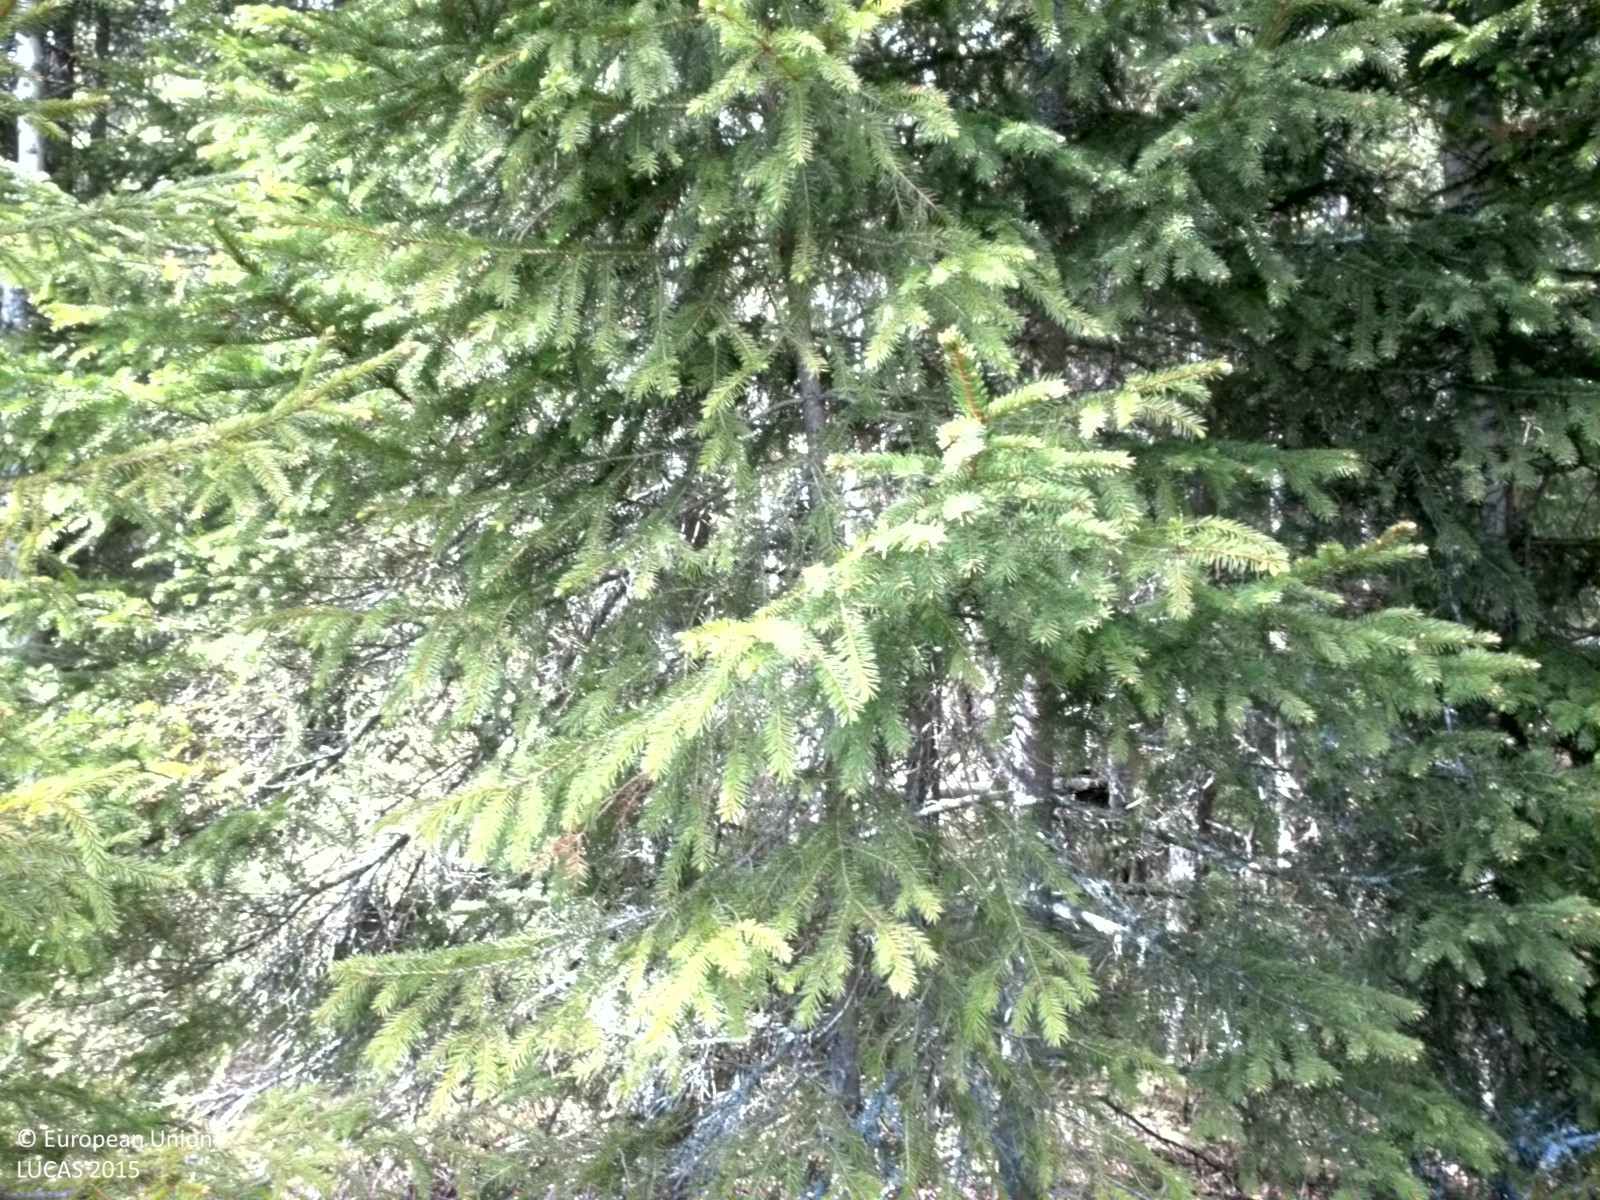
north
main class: Woodland
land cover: Spruce dominated mixed woodland
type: boreal forest
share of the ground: 50 - 75 %
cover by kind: herbaceous plants 50 %, coniferous forest trees 30 %, broadleaved forest trees 20 %
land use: Forestry
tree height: > 5 m
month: June
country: SE
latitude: 63.9490
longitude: 20.0819
